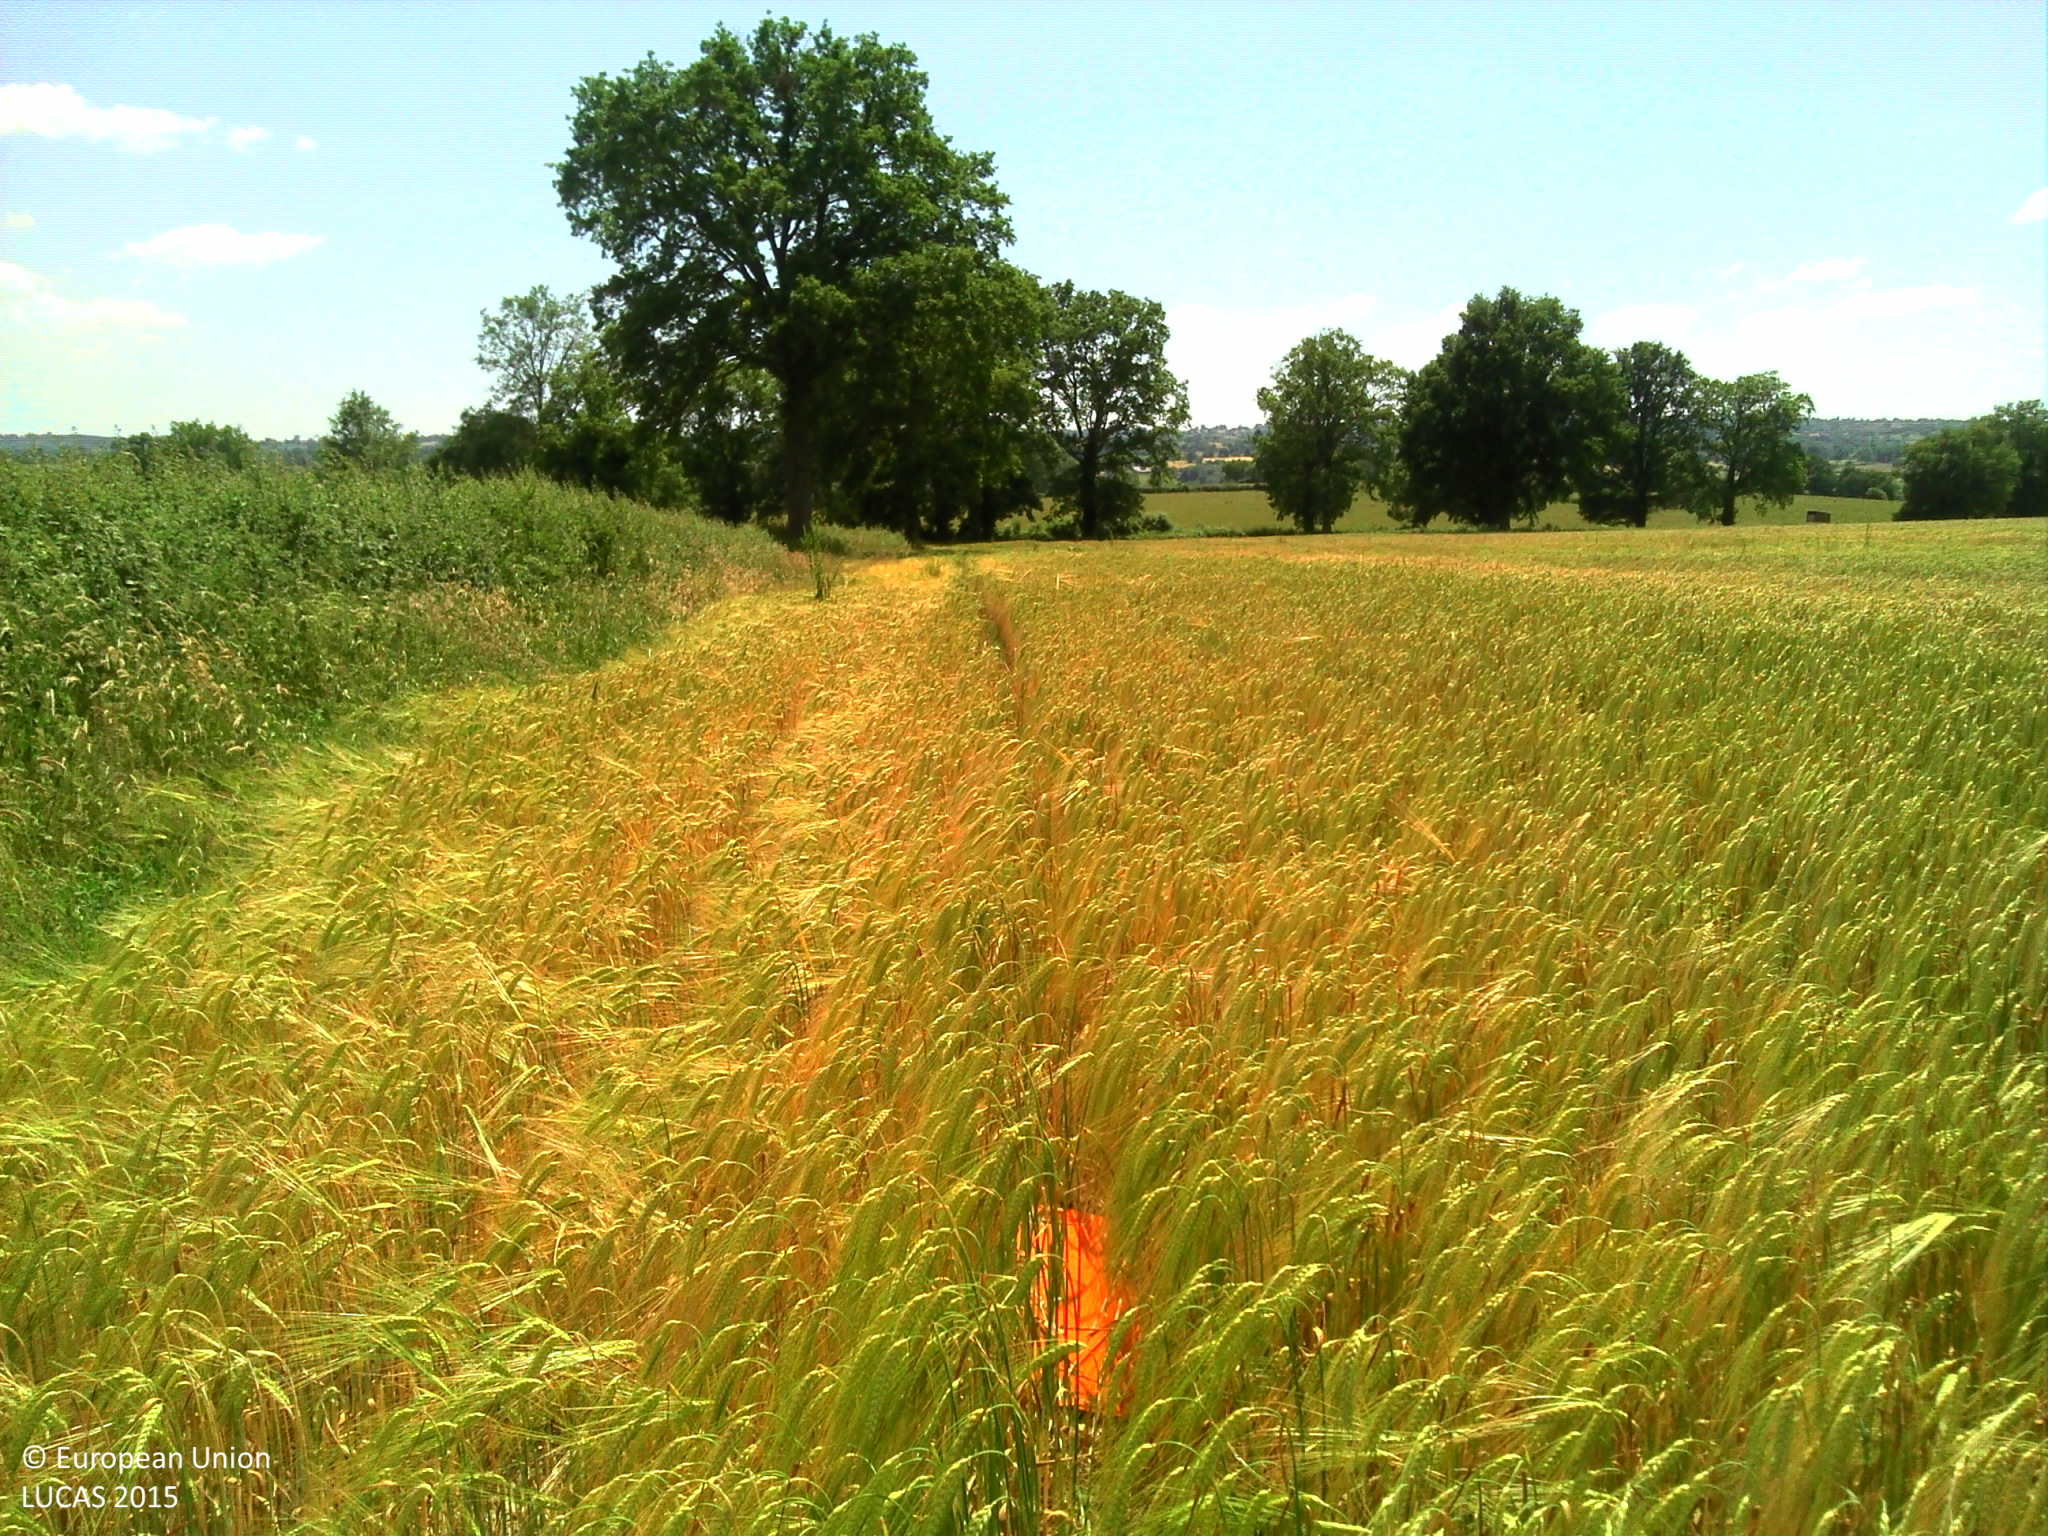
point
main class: Cropland
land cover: Barley
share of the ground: > 75 %
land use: Agriculture (excluding fallow land and kitchen gardens)
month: June
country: FR
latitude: 46.3298
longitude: 2.8657
